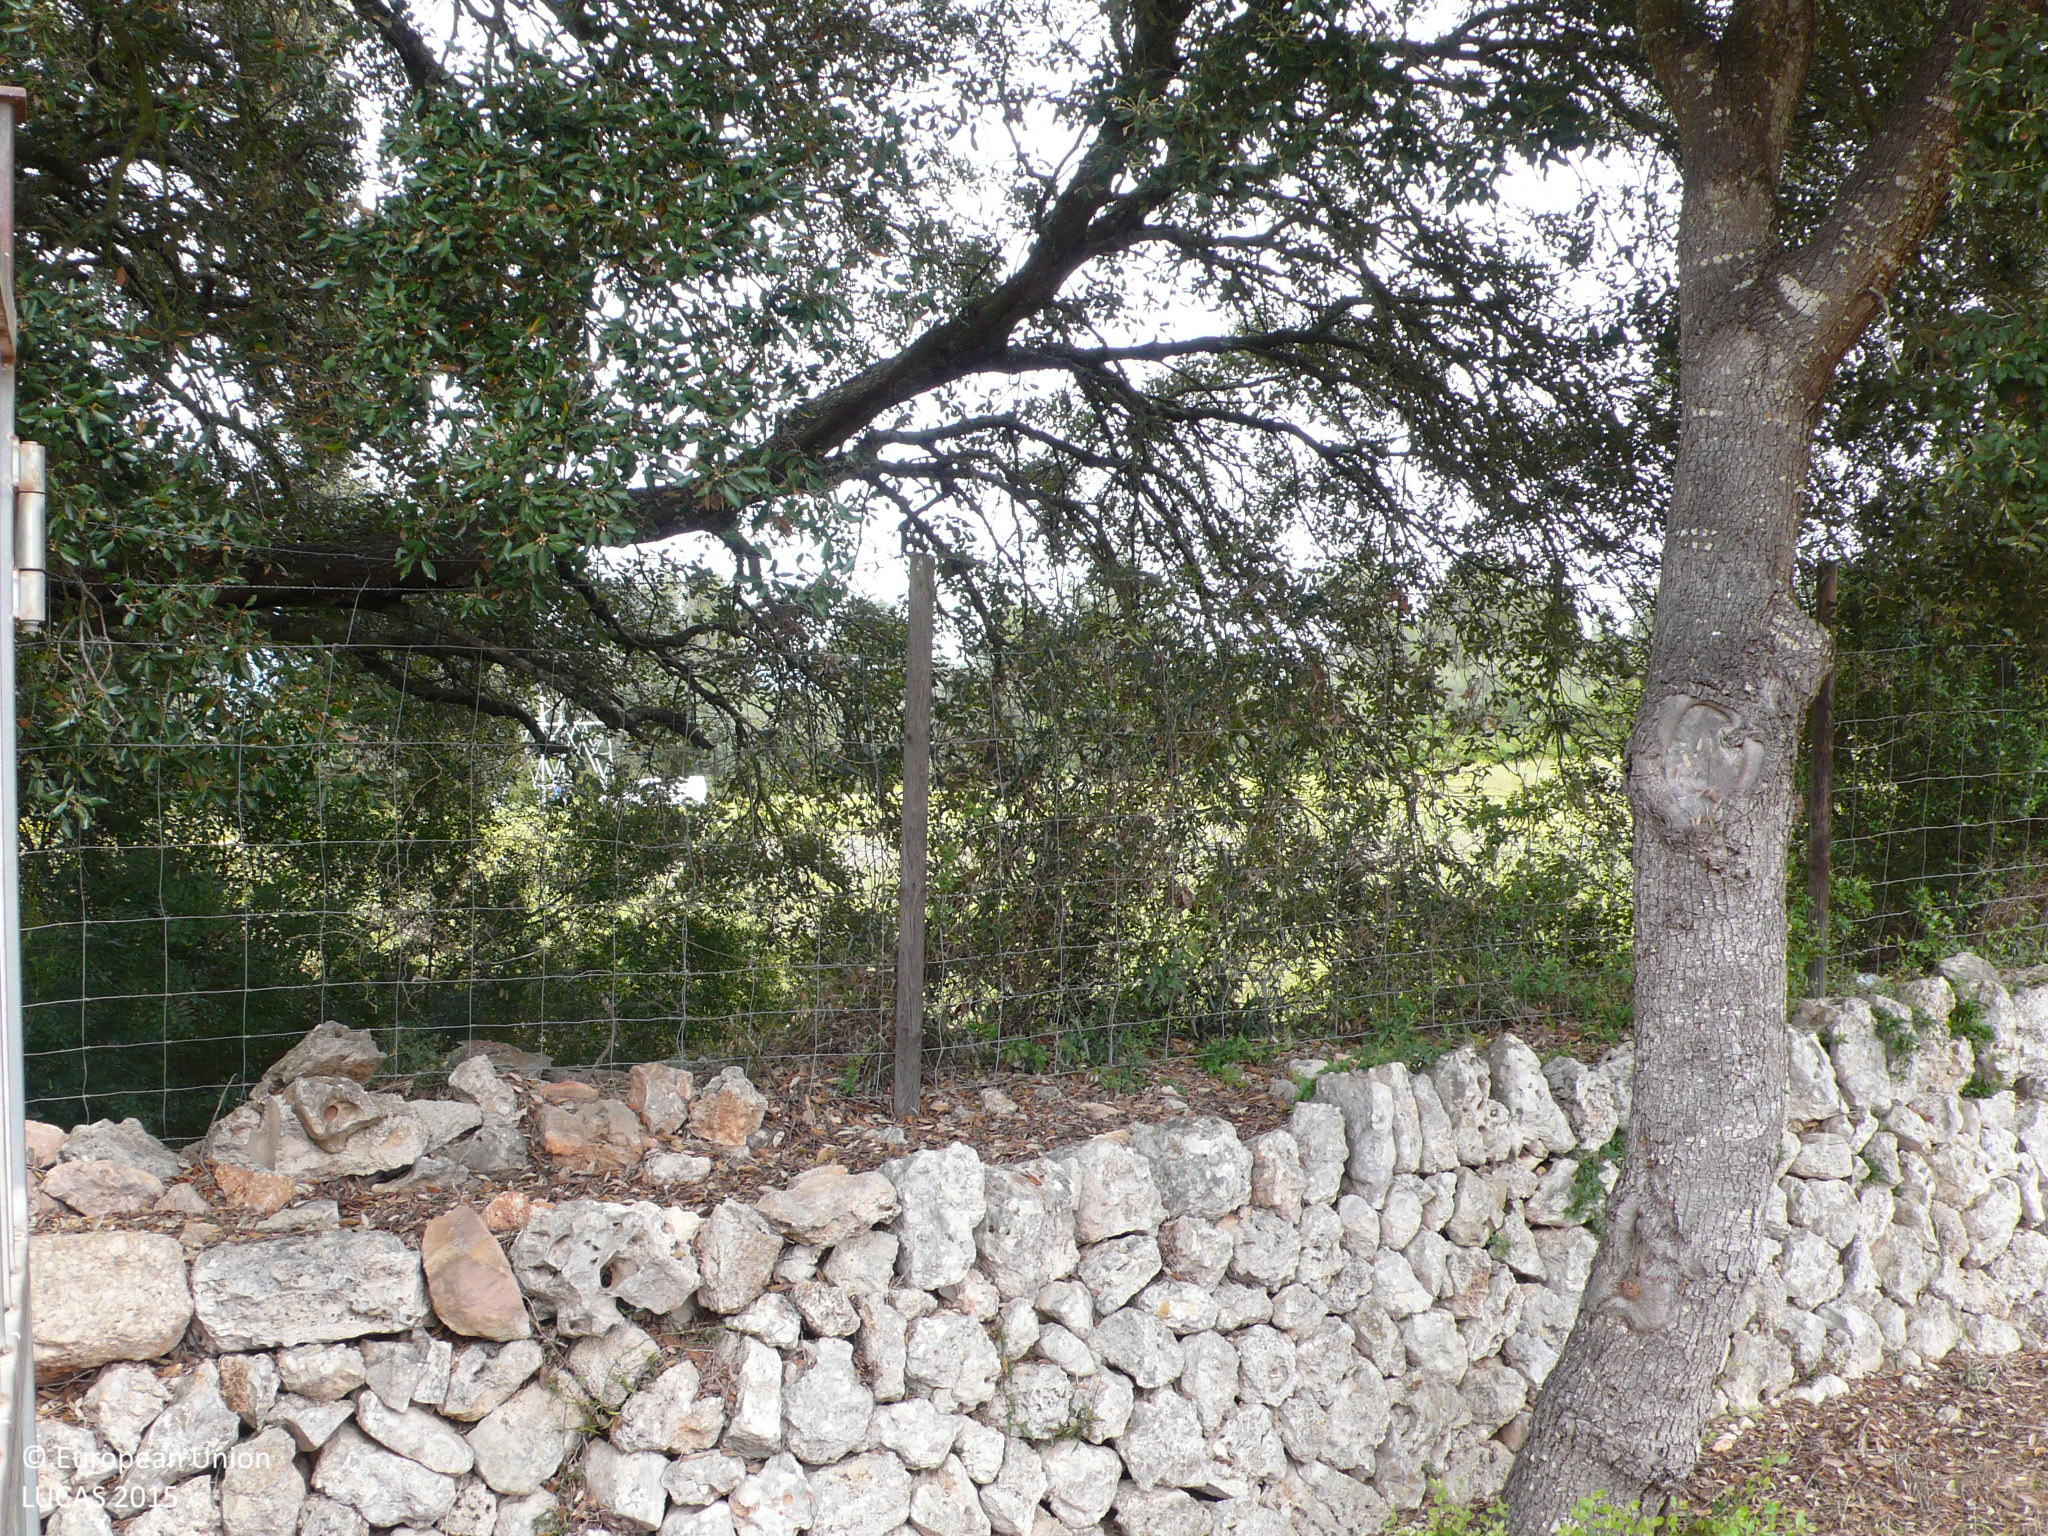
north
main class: Grassland
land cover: Spontaneously vegetated surfaces
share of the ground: > 75 %
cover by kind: herbaceous plants 100 %
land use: Fallow land
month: April
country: ES
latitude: 39.6095
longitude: 2.8903
